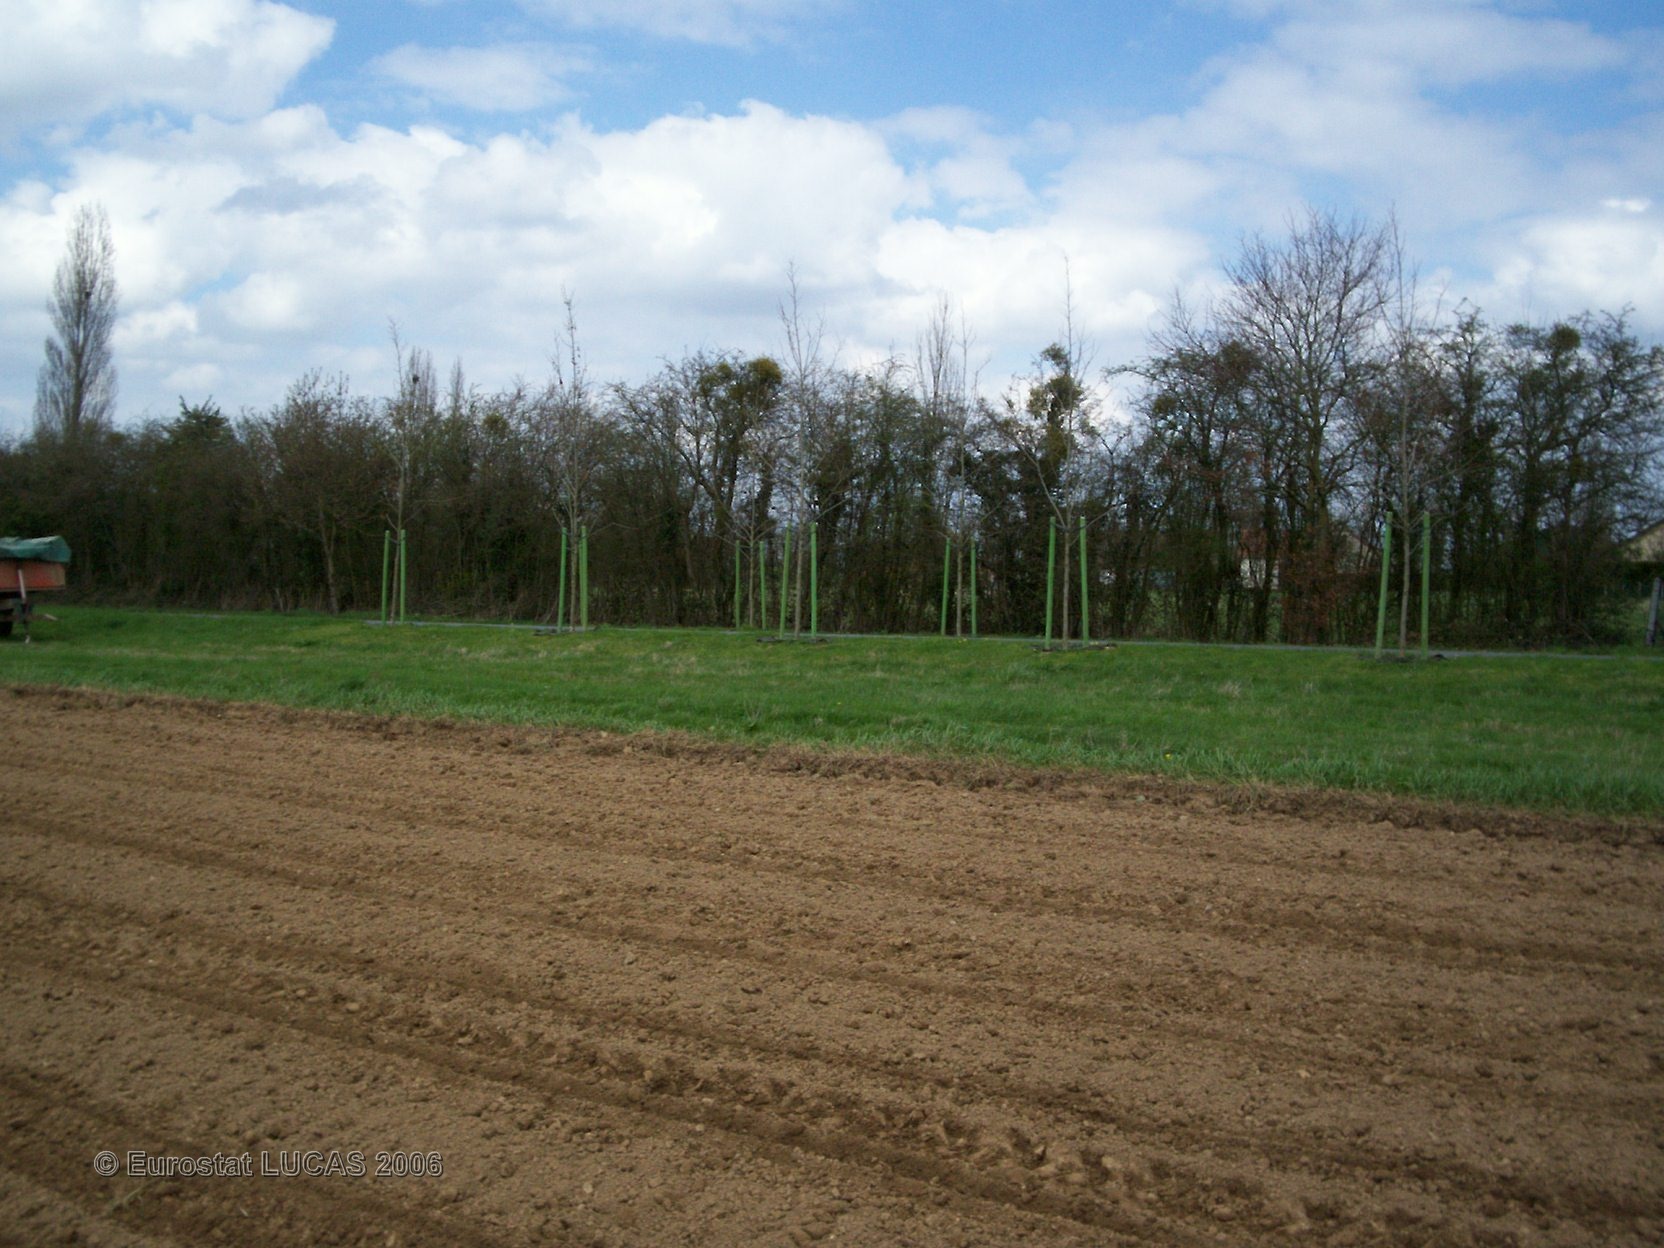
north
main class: Cropland
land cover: Maize
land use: Agriculture (excluding fallow land and kitchen gardens)
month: April
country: FR
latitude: 49.0887
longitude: 1.0369
